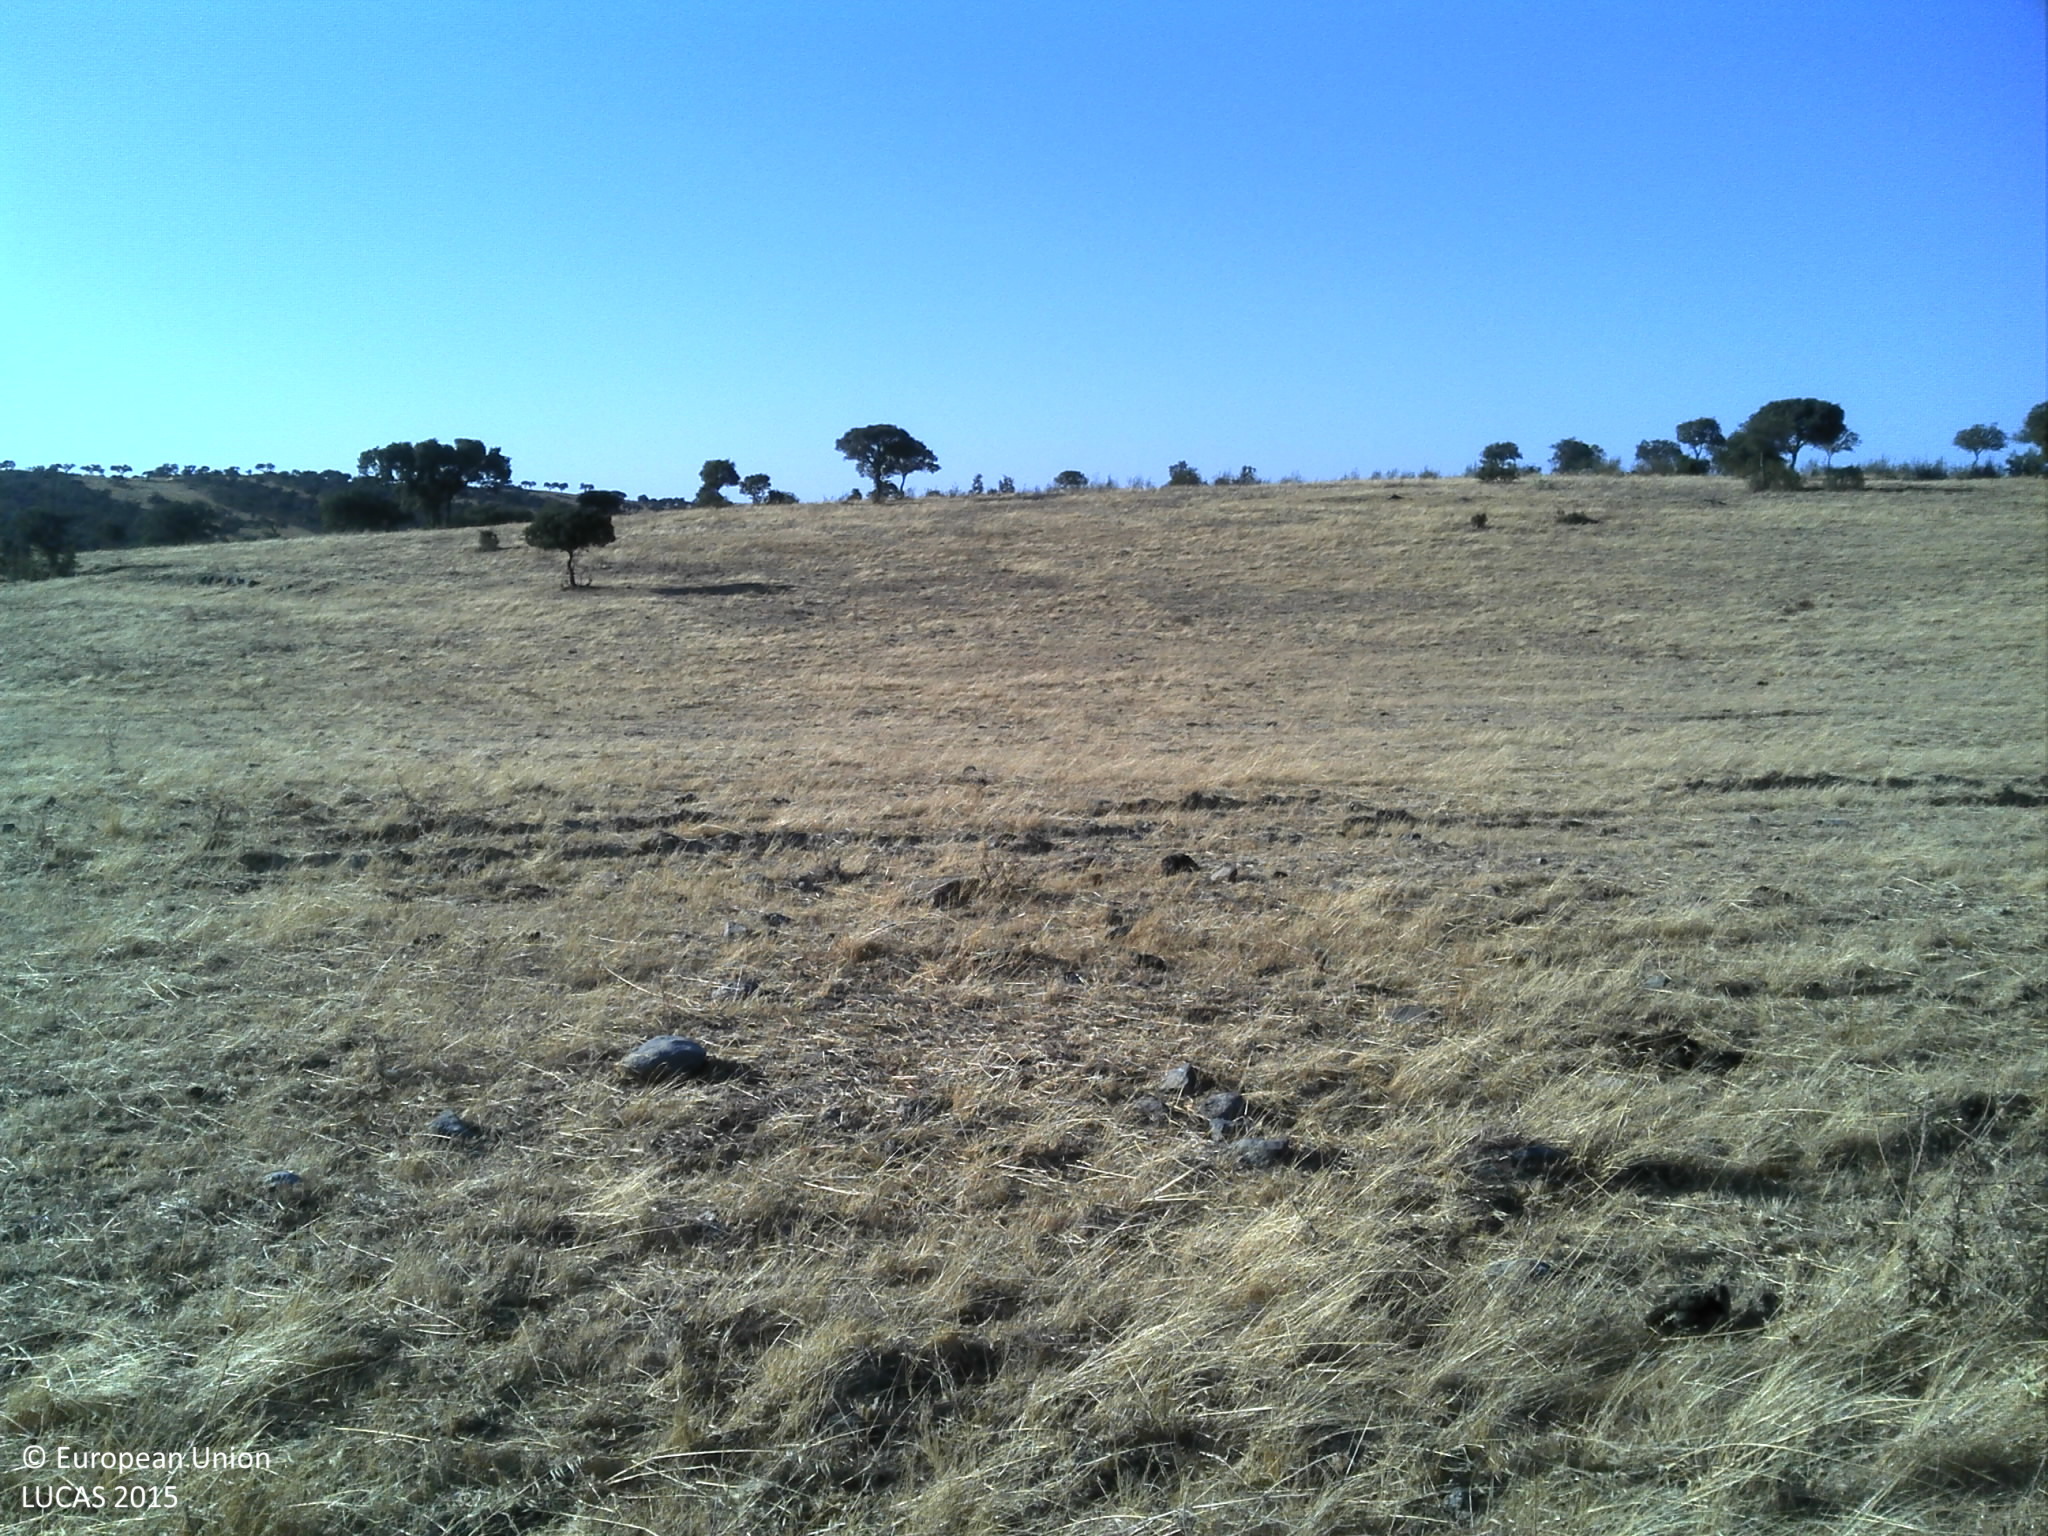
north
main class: Grassland
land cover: Grassland with sparse tree/shrub cover
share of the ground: > 75 %
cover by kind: herbaceous plants 90 %, broadleaved forest trees 5 %, unconsolidated bare surface 5 %
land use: Agriculture (excluding fallow land and kitchen gardens)
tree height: < 5 m
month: July
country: PT
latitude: 37.7208
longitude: -7.9838
